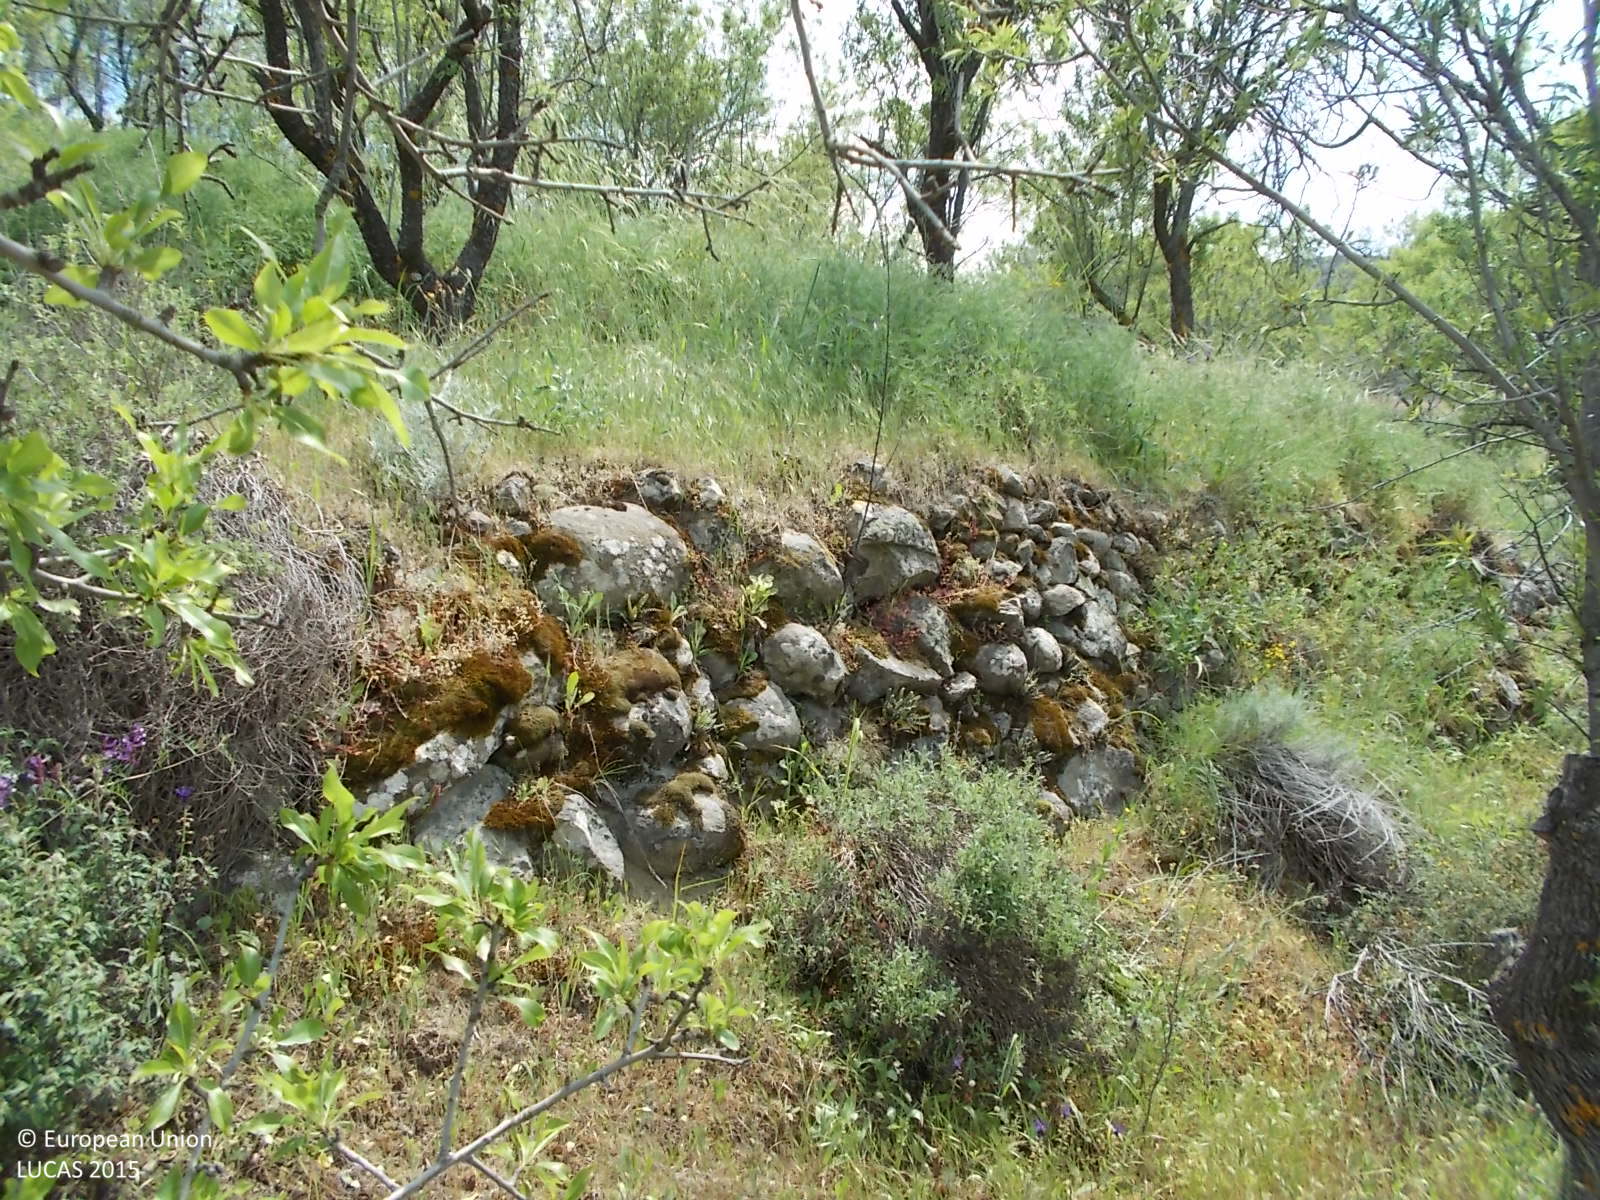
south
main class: Cropland
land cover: Nuts trees
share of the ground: > 75 %
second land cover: Grassland without tree/shrub cover
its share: > 75 %
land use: Abandoned areas
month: May
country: CY
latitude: 34.9449
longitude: 33.0700
